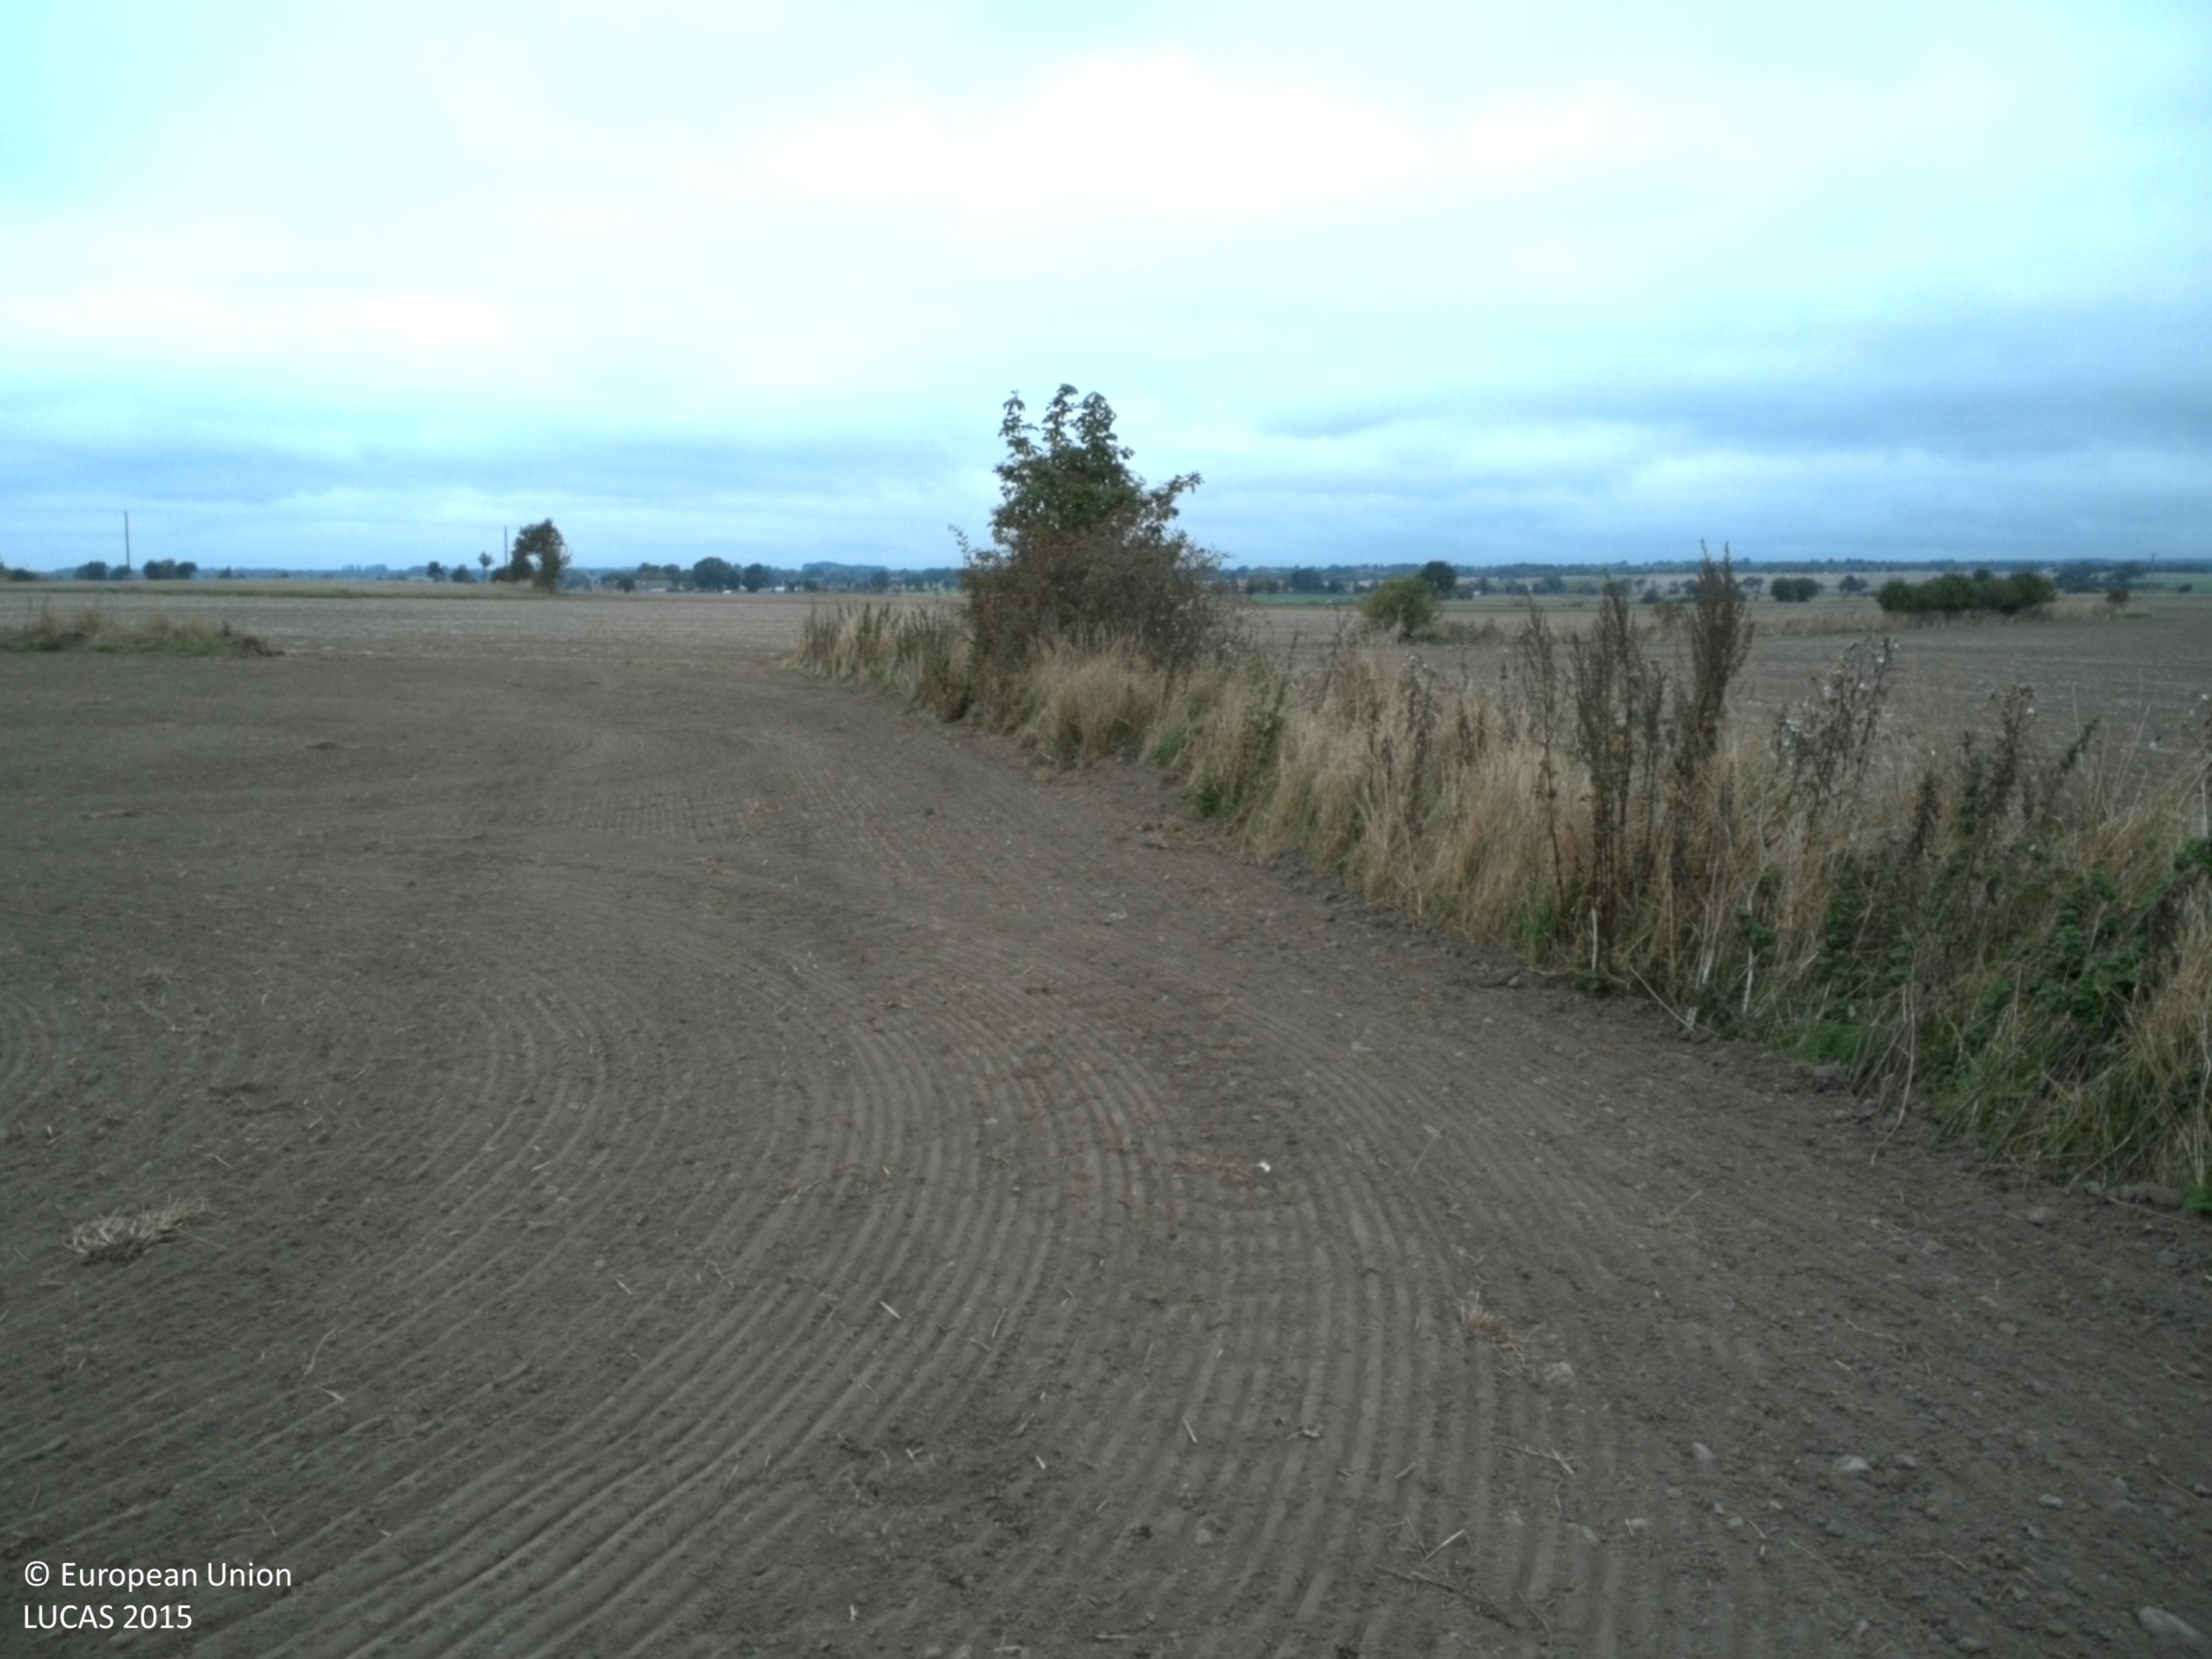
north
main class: Cropland
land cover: Common wheat
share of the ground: < 10 %
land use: Agriculture (excluding fallow land and kitchen gardens)
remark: Tilled/Sowed
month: October
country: SE
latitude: 55.5662
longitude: 14.0421
